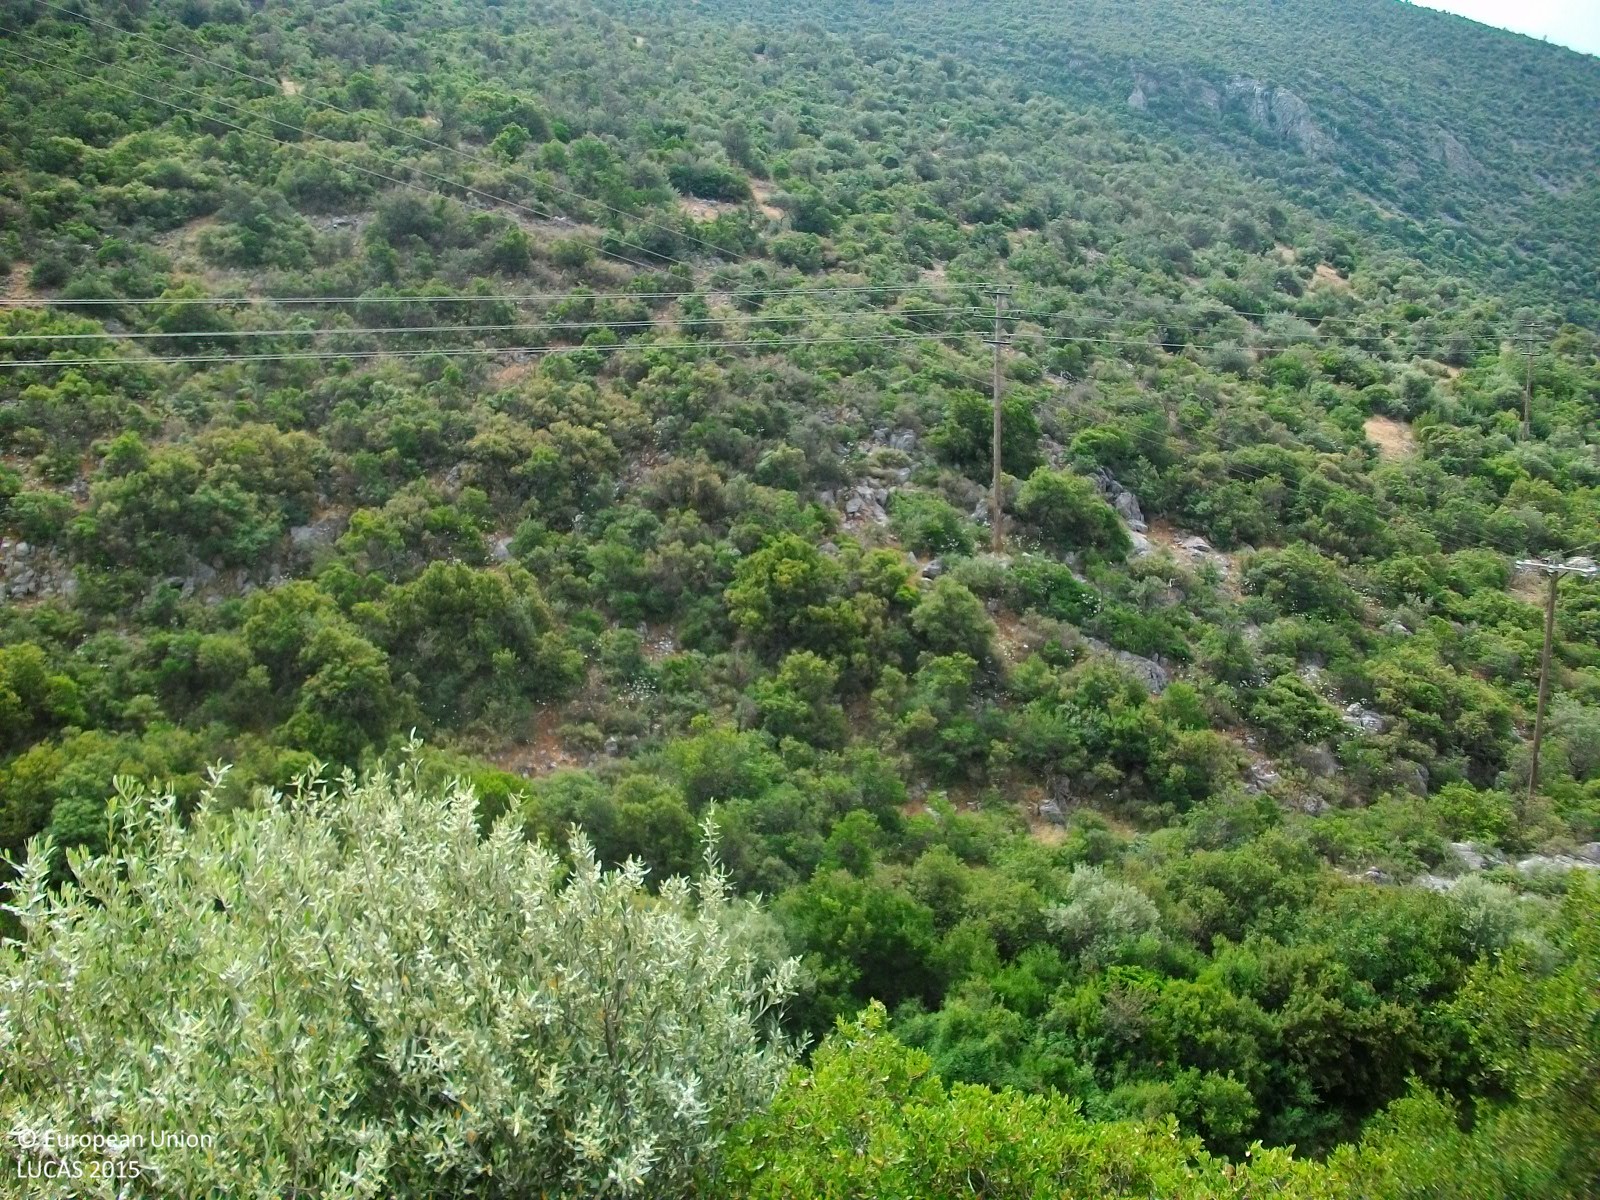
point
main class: Shrubland
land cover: Shrubland with sparse tree cover
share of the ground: > 75 %
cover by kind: shrubs 95 %, broadleaved forest trees 5 %
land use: Semi-natural and natural areas not in use
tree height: < 5 m
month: May
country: GR
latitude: 38.9402
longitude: 22.5925
